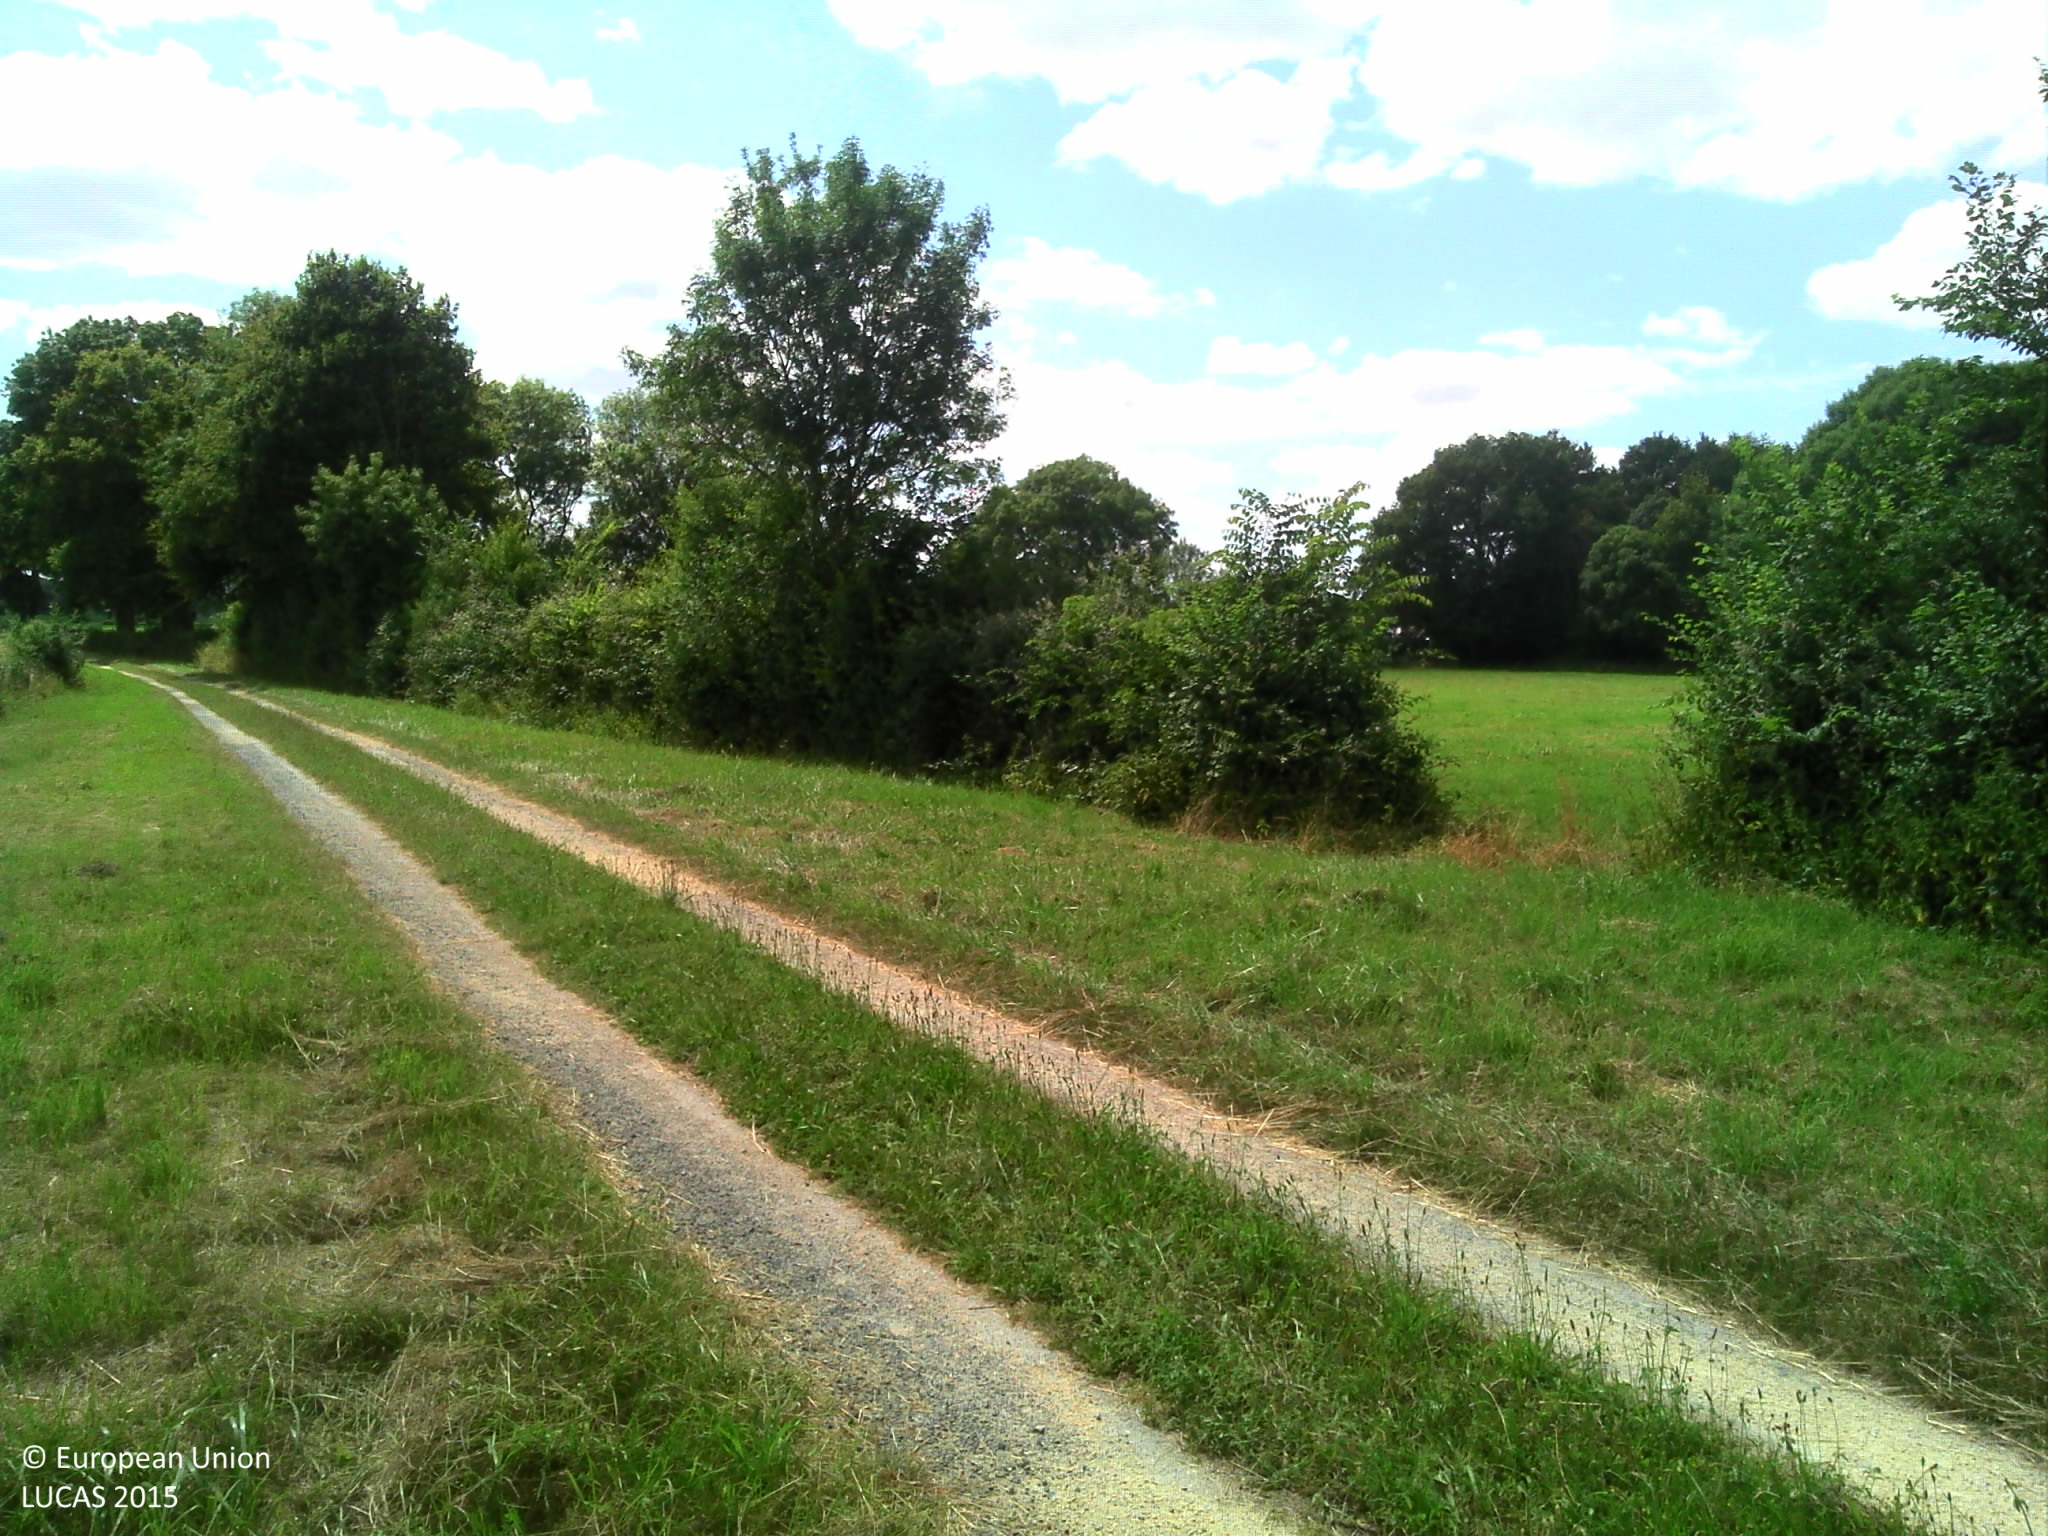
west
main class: Grassland
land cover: Grassland without tree/shrub cover
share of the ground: > 75 %
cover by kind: herbaceous plants 100 %
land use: Agriculture (excluding fallow land and kitchen gardens)
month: June
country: FR
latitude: 47.4714
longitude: 0.3313
